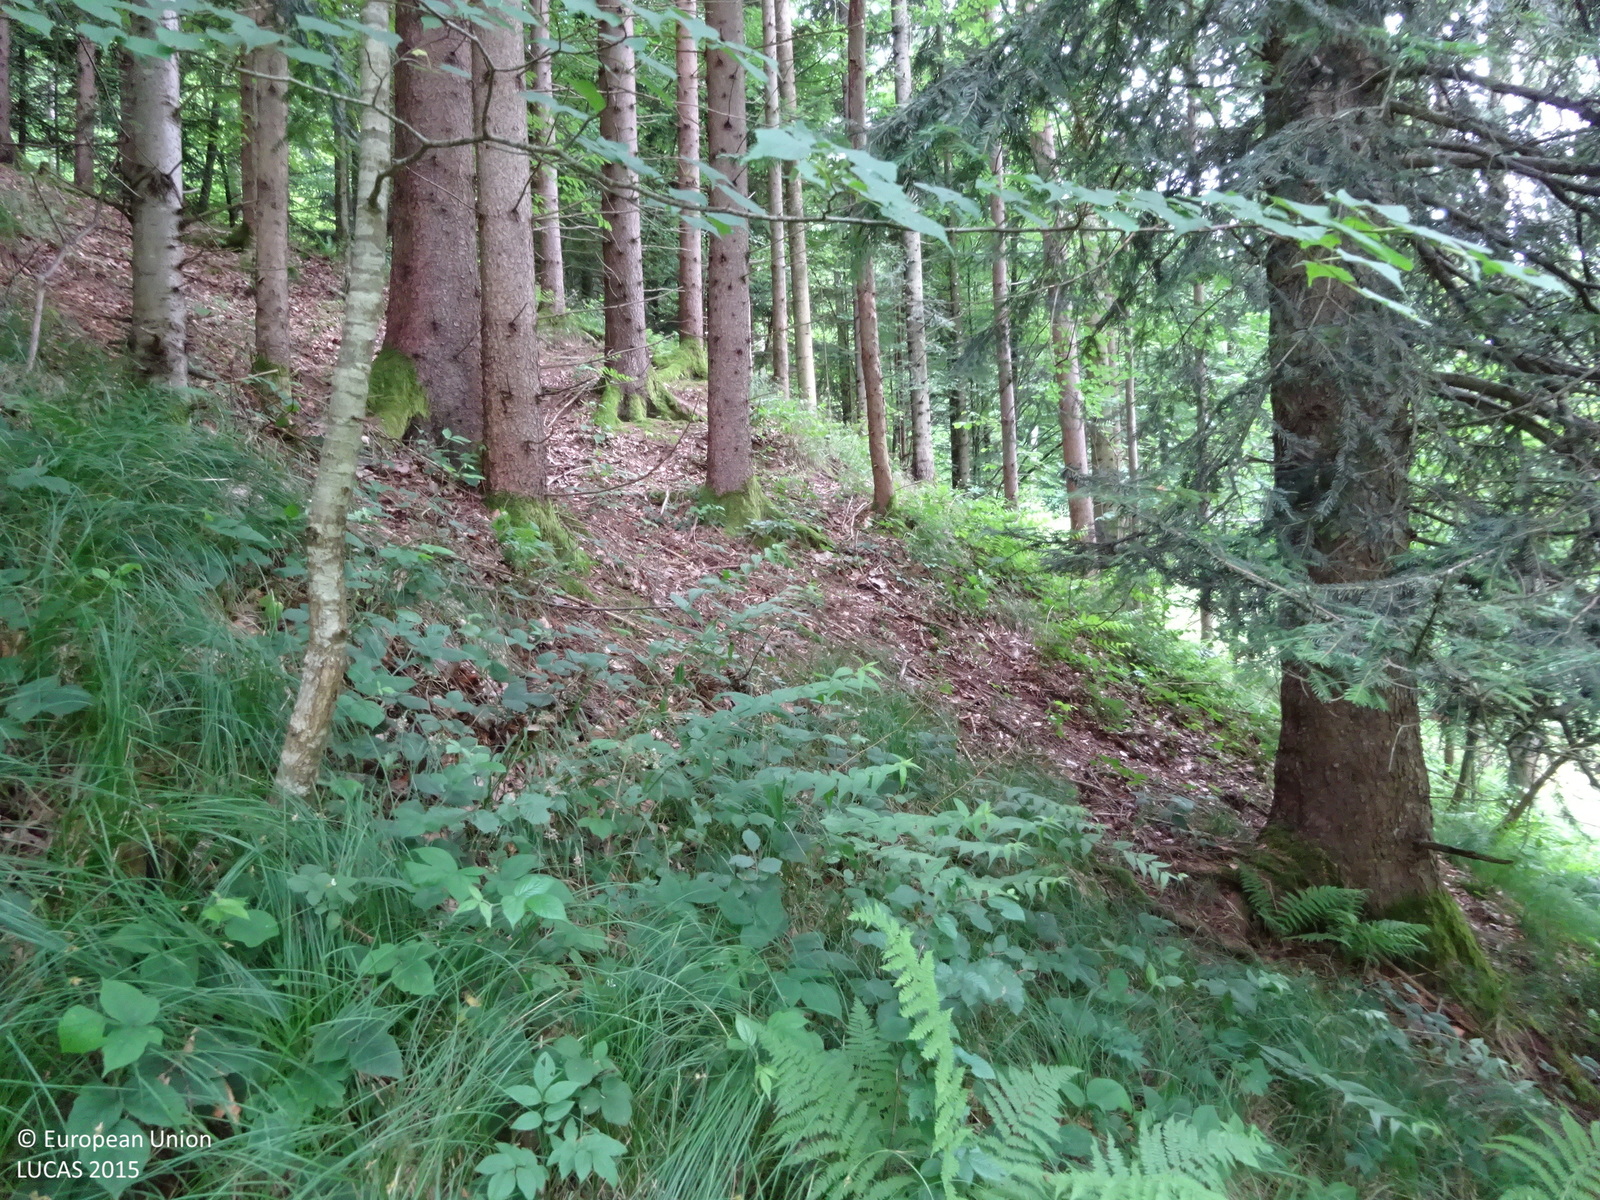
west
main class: Woodland
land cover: Spruce dominated mixed woodland
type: mountainous beech forest
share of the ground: > 75 %
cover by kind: broadleaved forest trees 75 %, coniferous forest trees 25 %
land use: Forestry
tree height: > 5 m
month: June
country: AT
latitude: 46.7533
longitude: 15.4582
